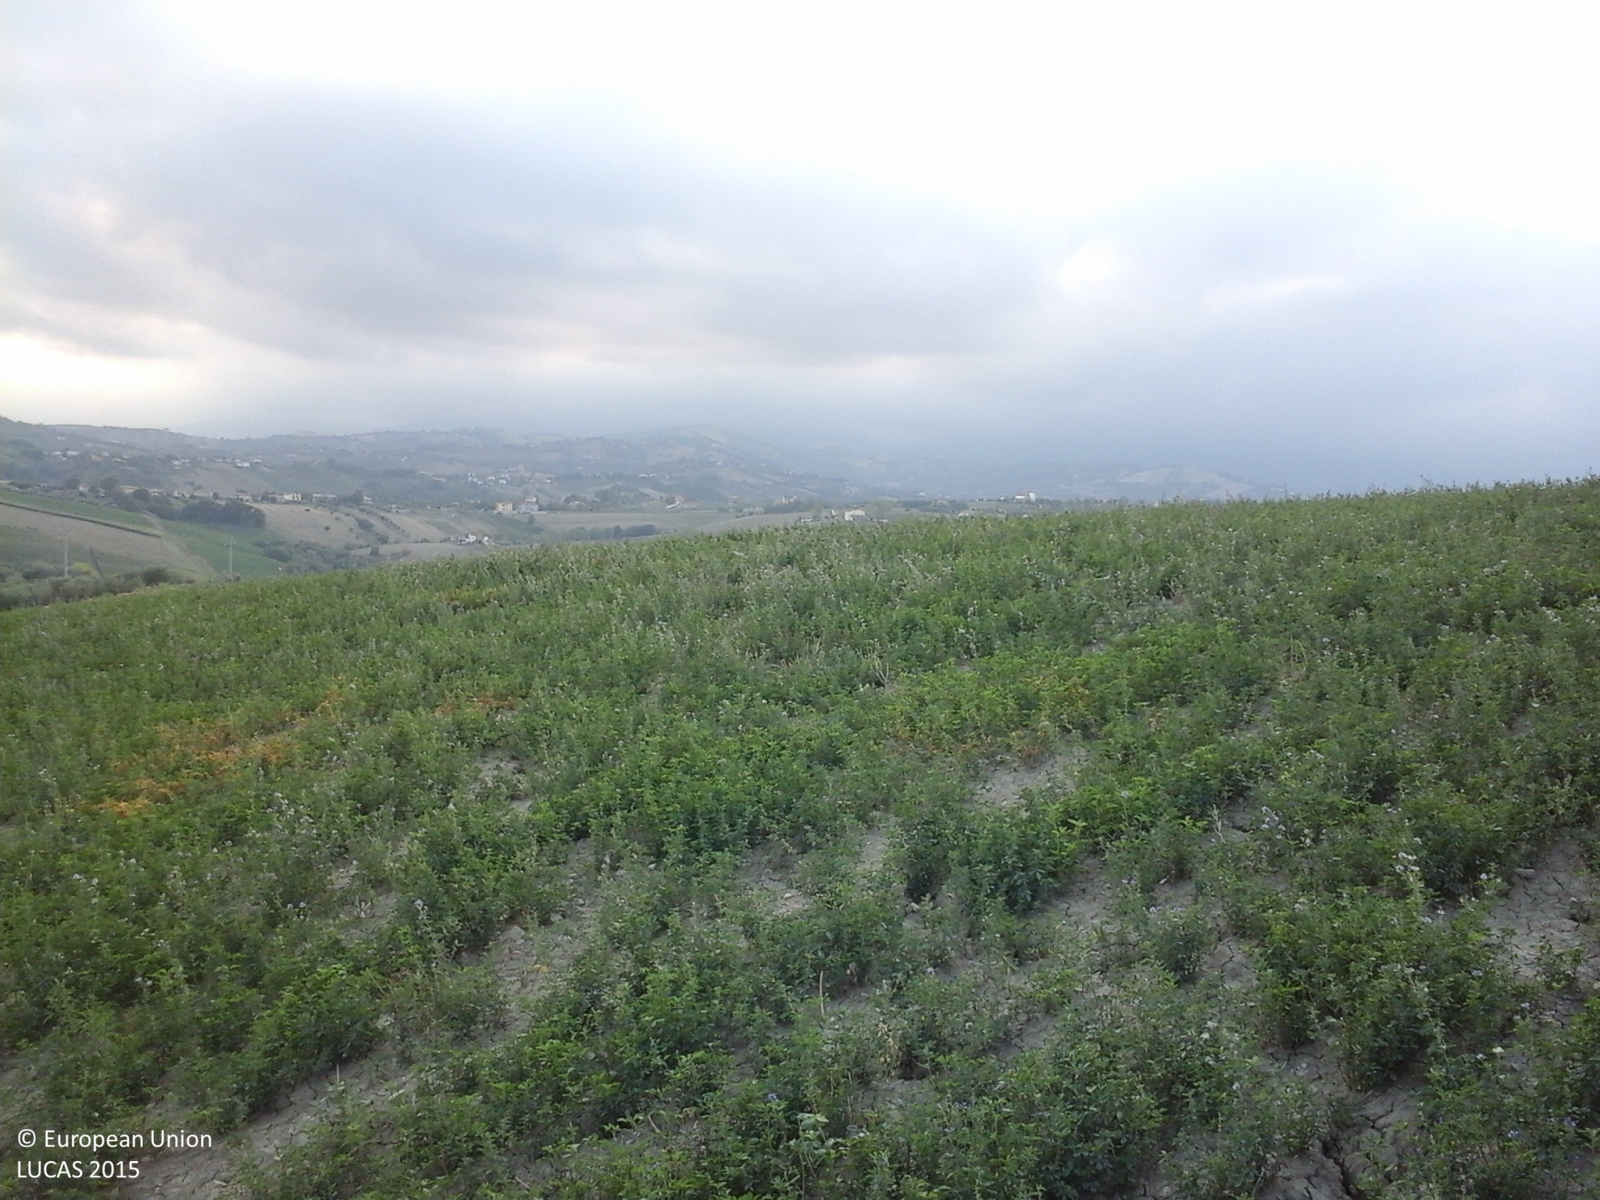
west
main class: Cropland
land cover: Lucerne
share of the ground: > 75 %
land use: Agriculture (excluding fallow land and kitchen gardens)
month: August
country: IT
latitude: 42.7098
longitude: 13.7862
